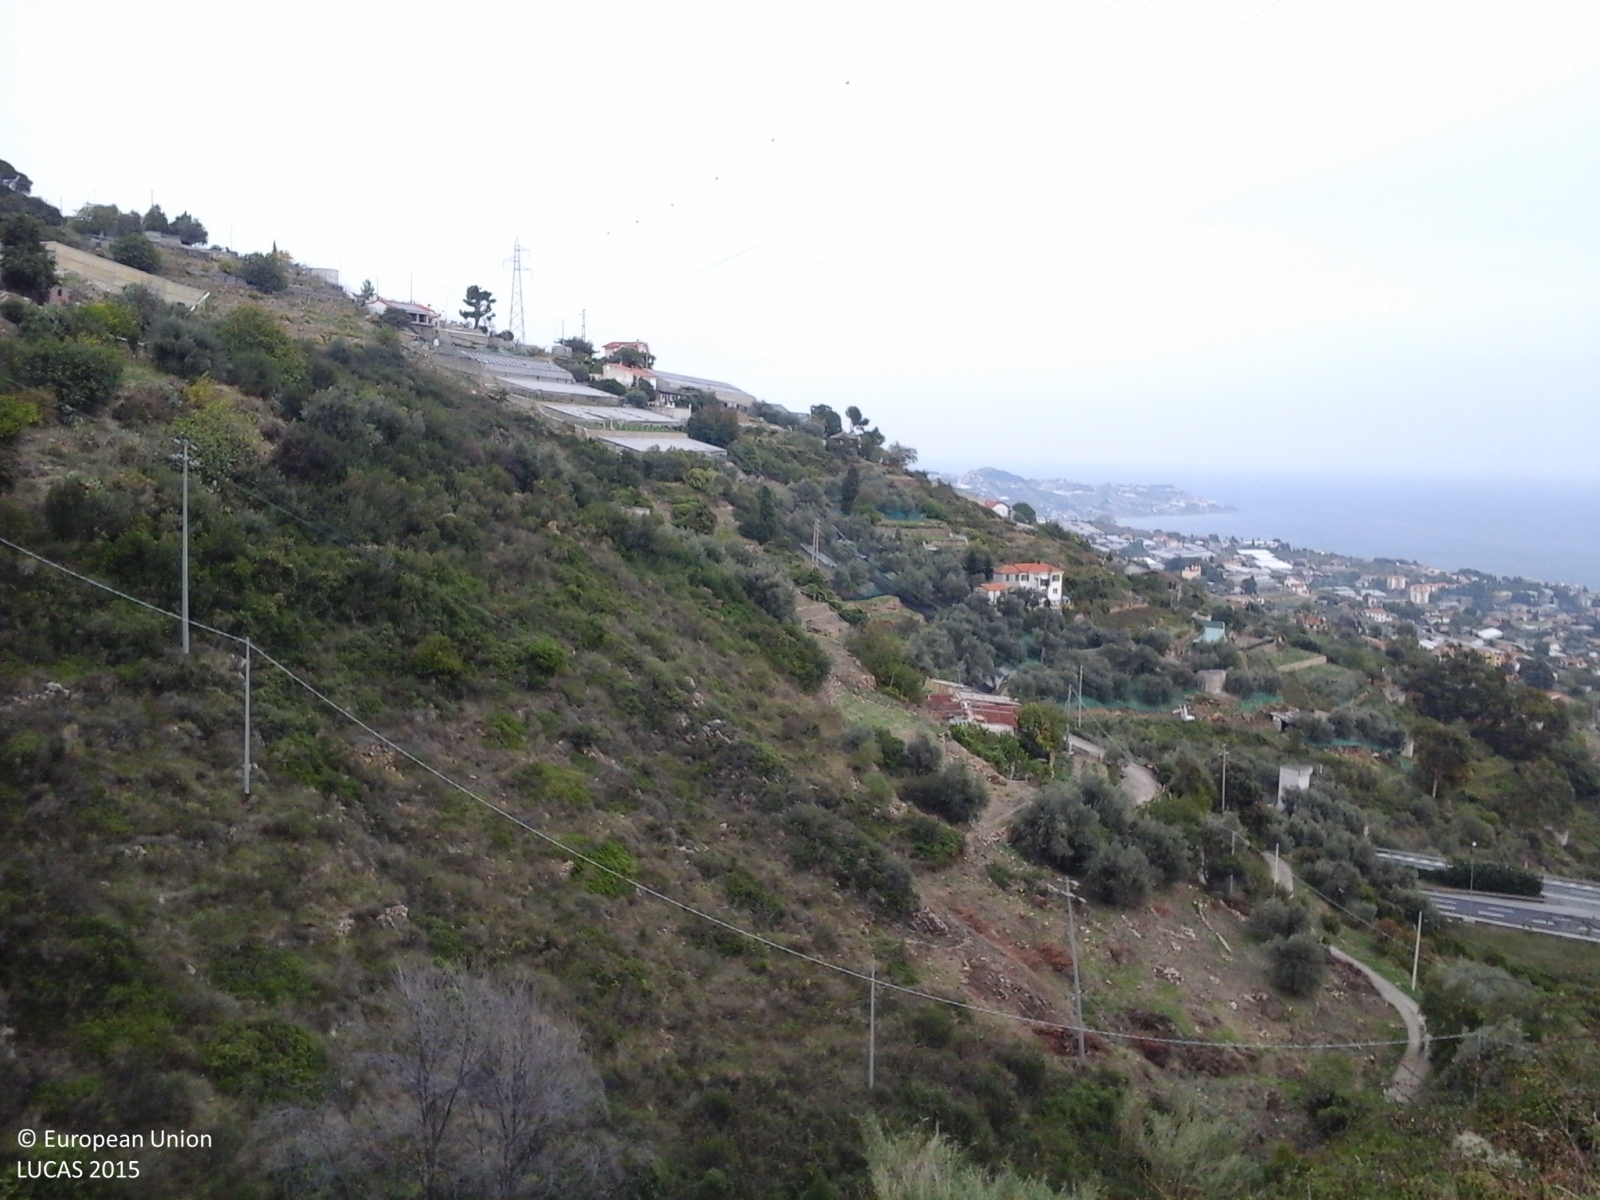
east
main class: Shrubland
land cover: Shrubland with sparse tree cover
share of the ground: > 75 %
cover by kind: shrubs 60 %, herbaceous plants 30 %, broadleaved forest trees 5 %, consolidated bare surface 5 %
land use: Semi-natural and natural areas not in use
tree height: > 5 m
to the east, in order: Shrubland with sparse tree cover; Electric lines; Shrubland with sparse tree cover; Dry stone walls; Olive groves; Grassland without tree/shrub cover; Dry stone walls; Olive groves; Grassland without tree/shrub cover; Electric lines; Paved roads, cycling and walking lanes; Shrubland without tree cover; Electric lines; Shrubland with sparse tree cover; Tracks; Olive groves; Grassland without tree/shrub cover; Electric lines; Olive groves; Grassland without tree/shrub cover; Fences; Paved roads, cycling and walking lanes; Grassland with sparse tree/shrub cover; Paved roads, cycling and walking lanes; Fences; Olive groves; Grassland without tree/shrub cover; Olive groves
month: October
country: IT
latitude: 43.8205
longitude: 7.7303
